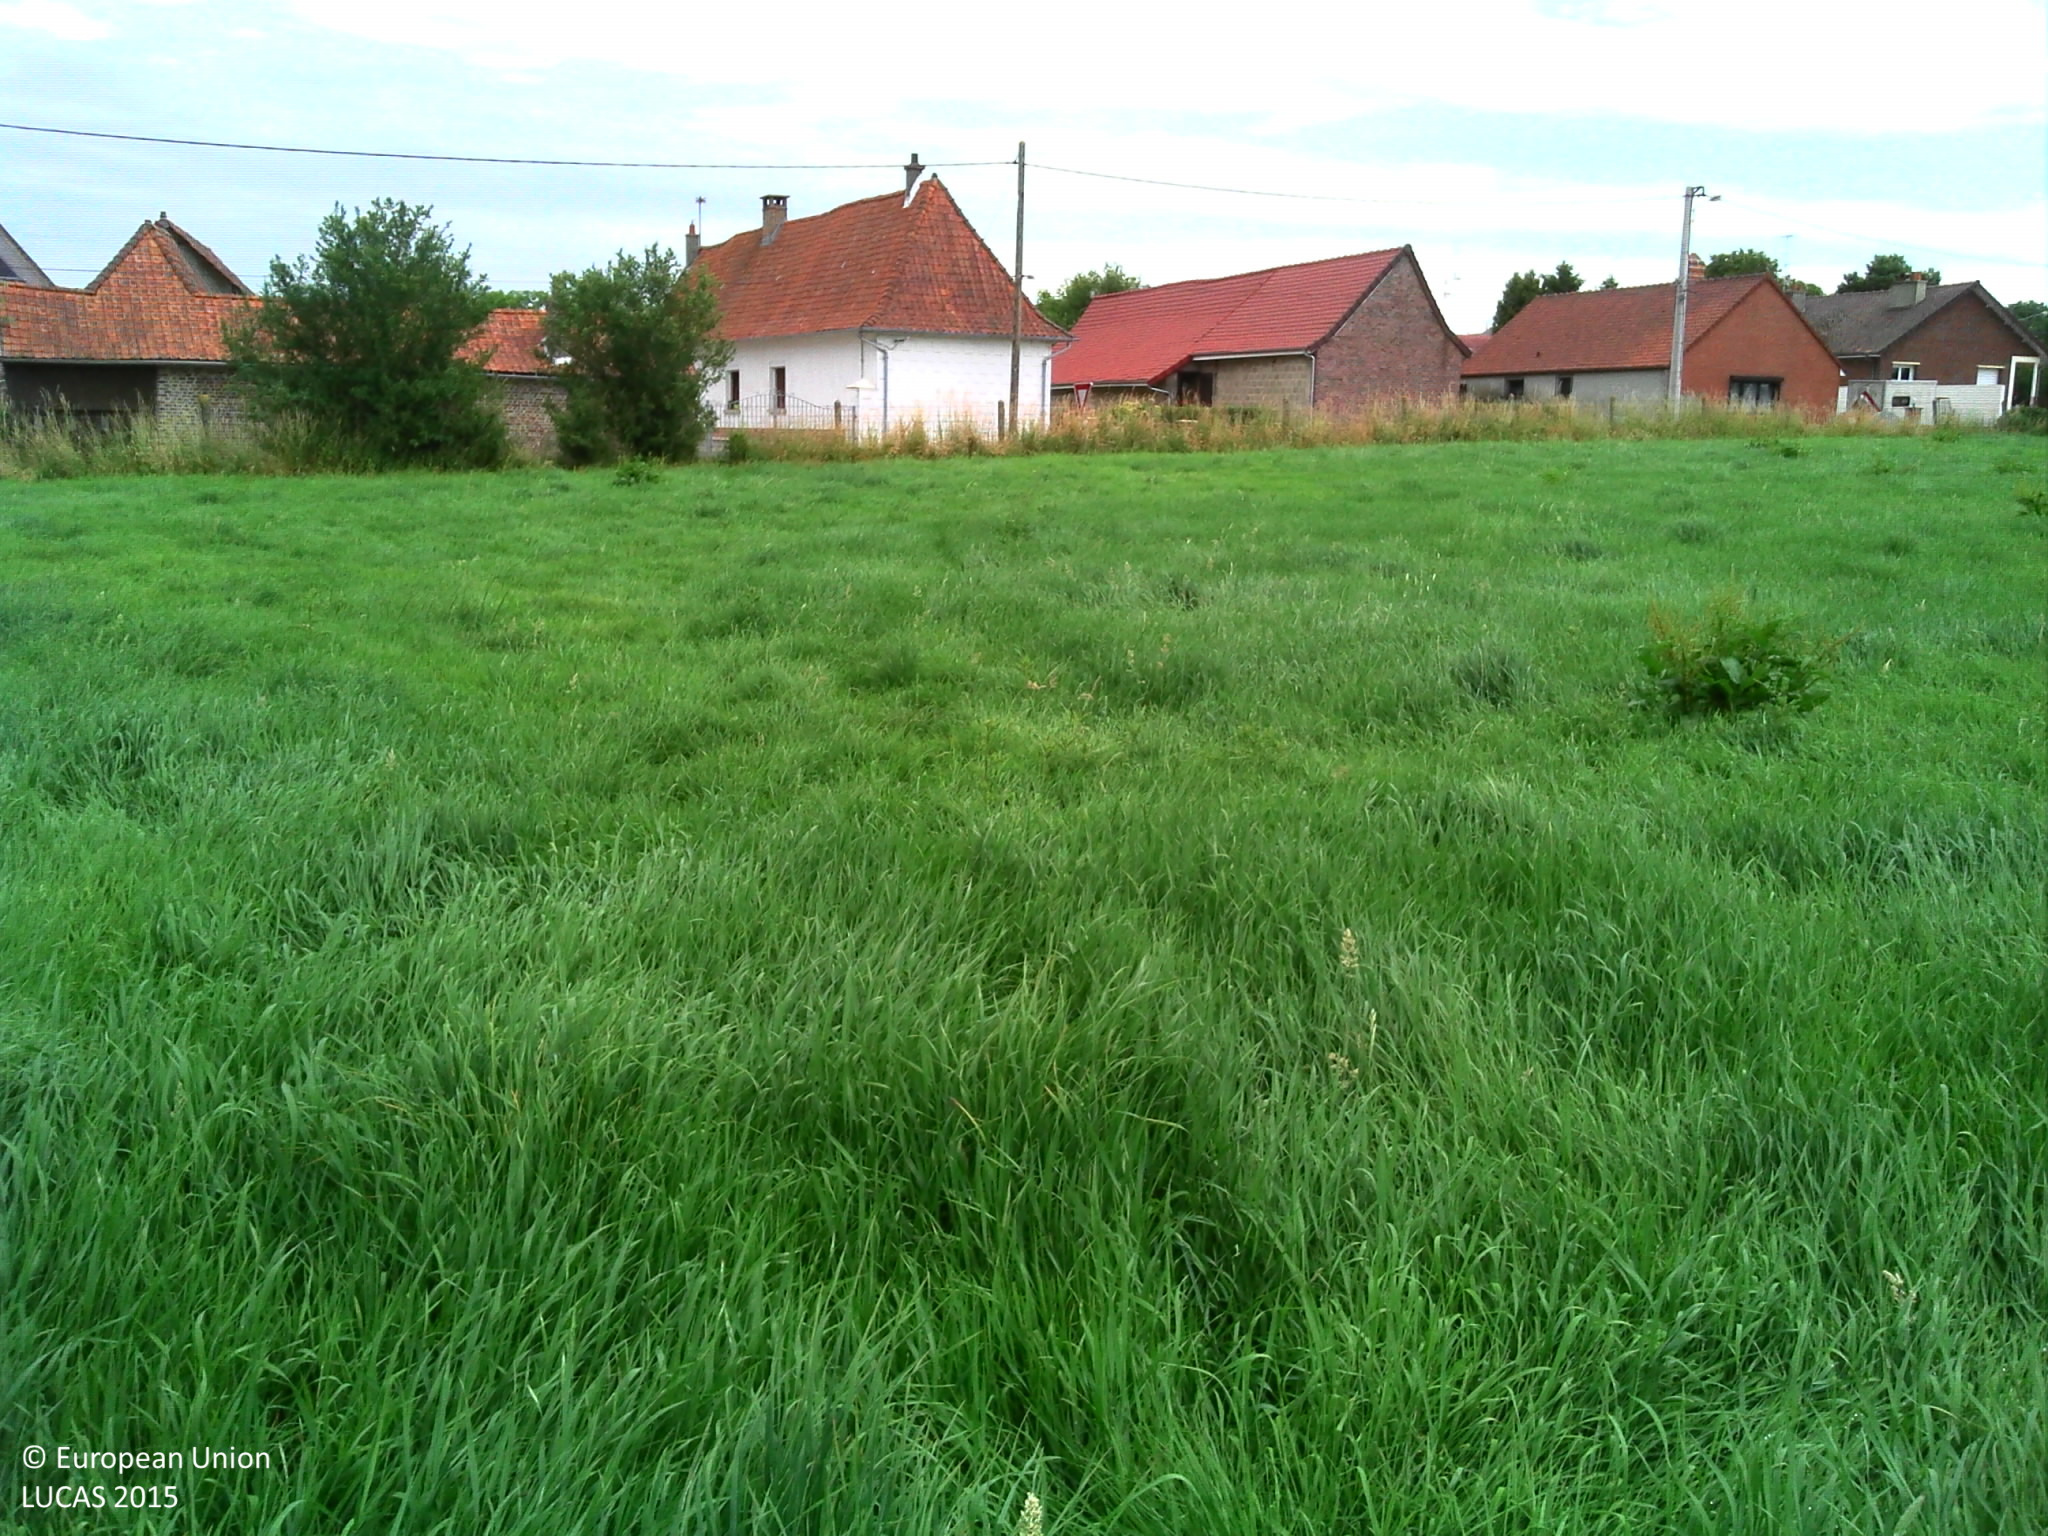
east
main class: Grassland
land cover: Grassland without tree/shrub cover
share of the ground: > 75 %
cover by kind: herbaceous plants 100 %
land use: Agriculture (excluding fallow land and kitchen gardens)
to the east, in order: Grassland without tree/shrub cover; Artificial constructions in urban areas
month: July
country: FR
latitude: 50.3794
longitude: 2.0959
